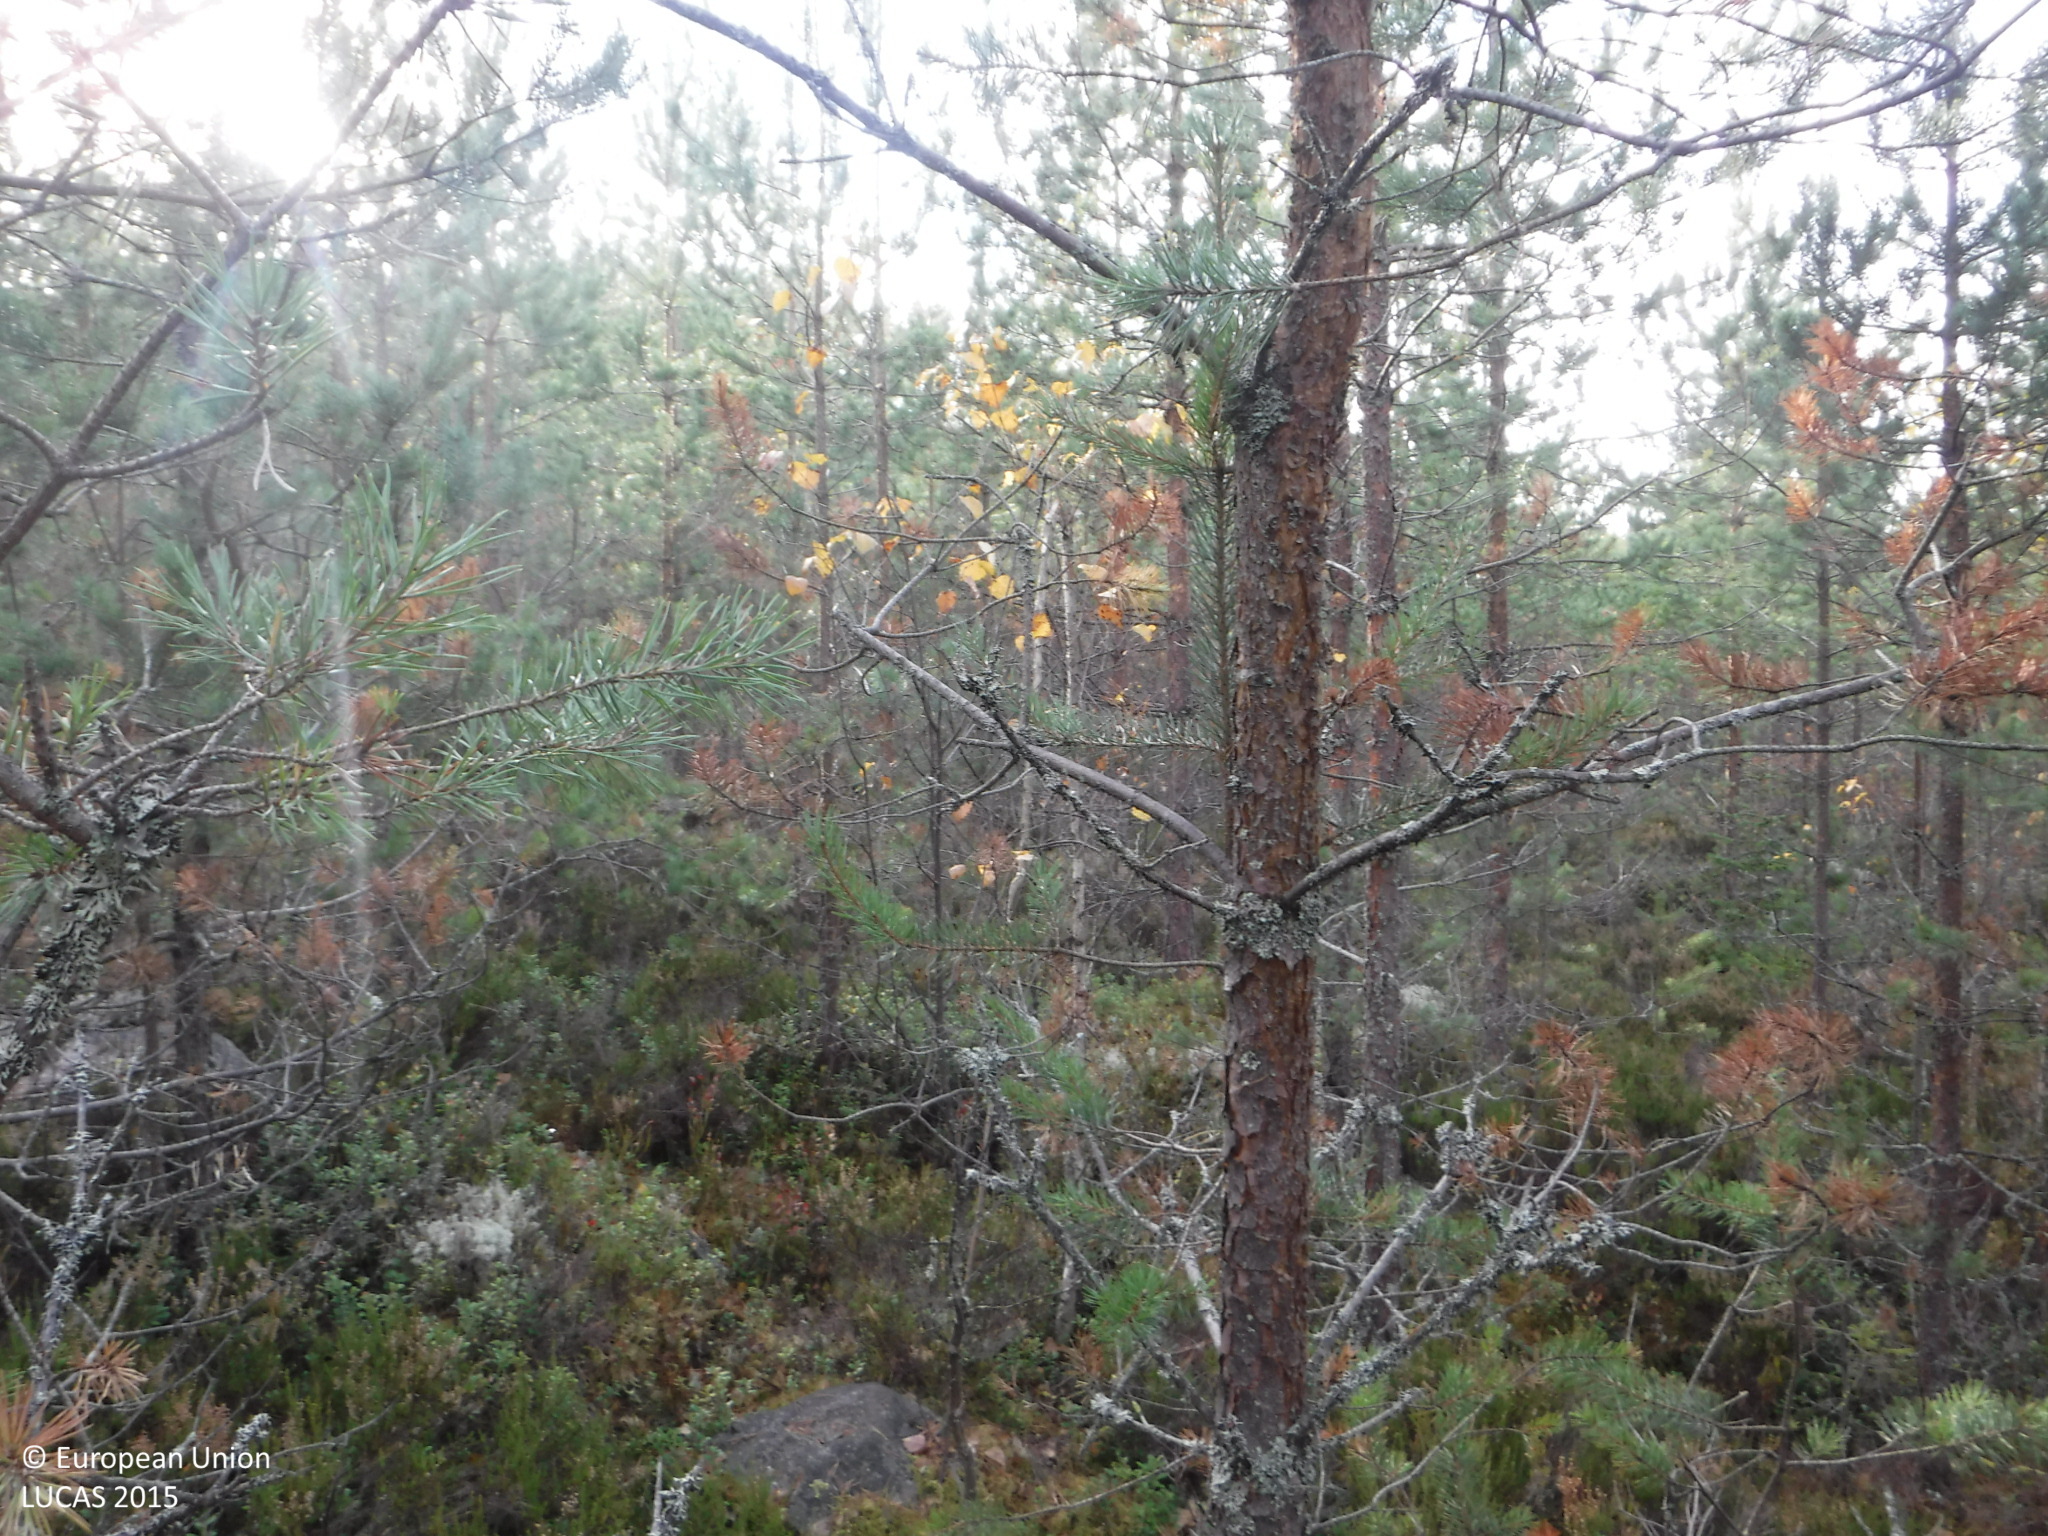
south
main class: Woodland
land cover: Pine dominated coniferous woodland
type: boreal forest
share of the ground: 50 - 75 %
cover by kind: coniferous forest trees 70 %, shrubs 15 %, lichens and mosses 15 %
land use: Forestry
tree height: < 5 m
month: October
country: FI
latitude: 62.0417
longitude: 26.0178
